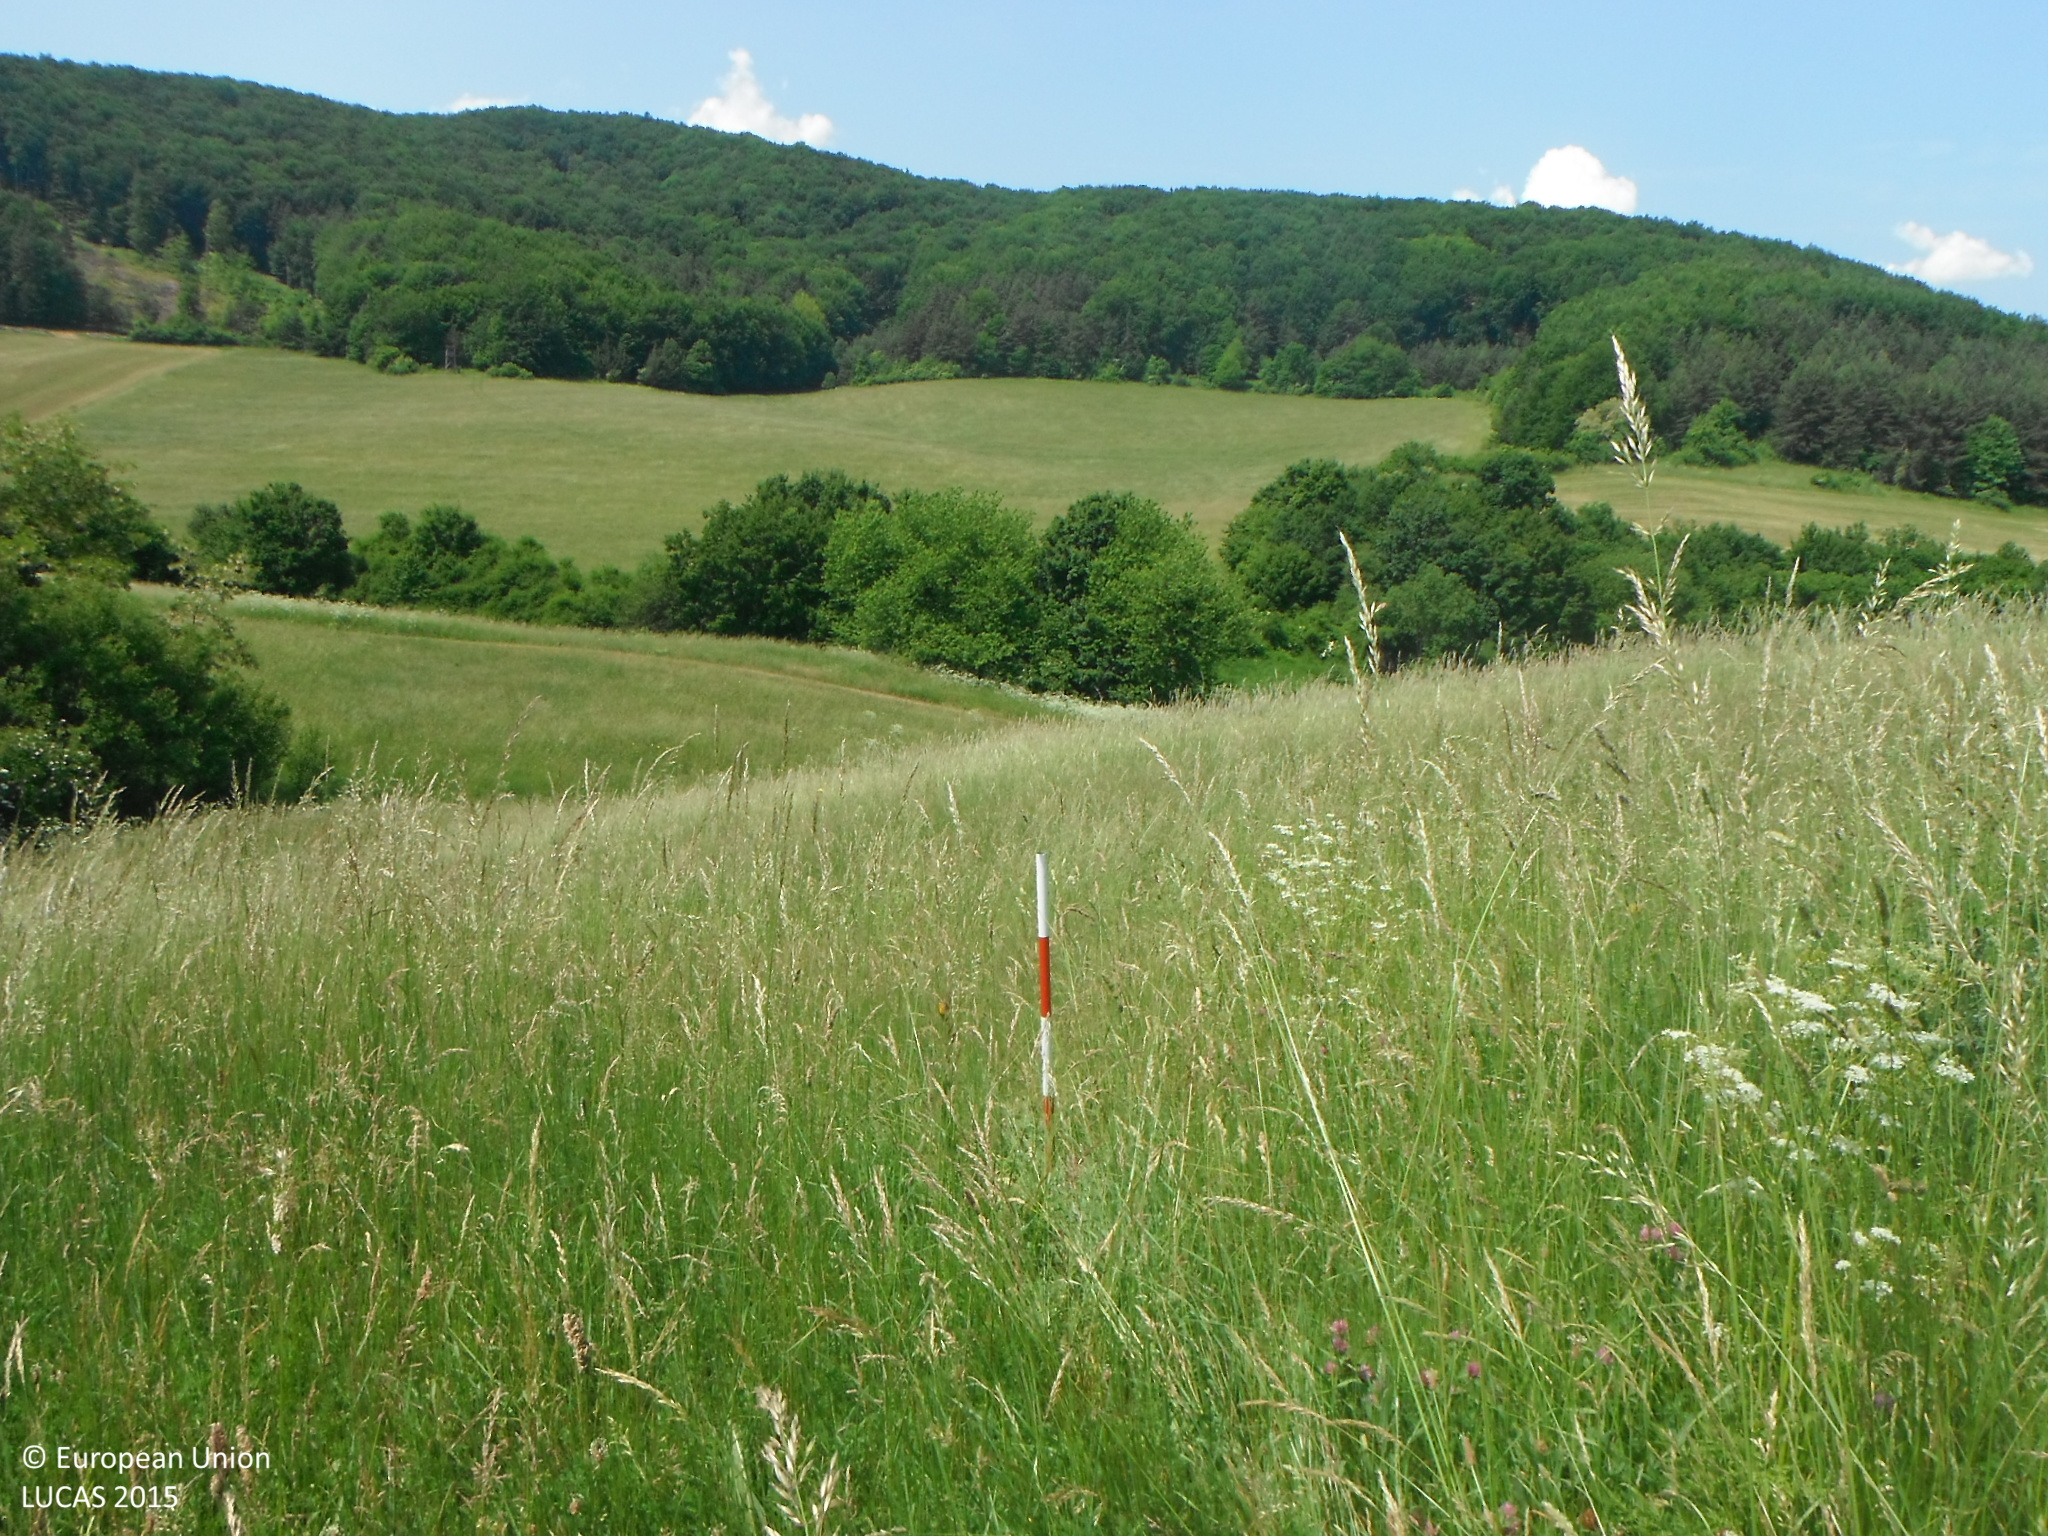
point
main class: Grassland
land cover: Grassland without tree/shrub cover
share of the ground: > 75 %
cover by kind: herbaceous plants 100 %
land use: Agriculture (excluding fallow land and kitchen gardens)
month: June
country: SK
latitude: 48.7077
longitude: 19.1955
